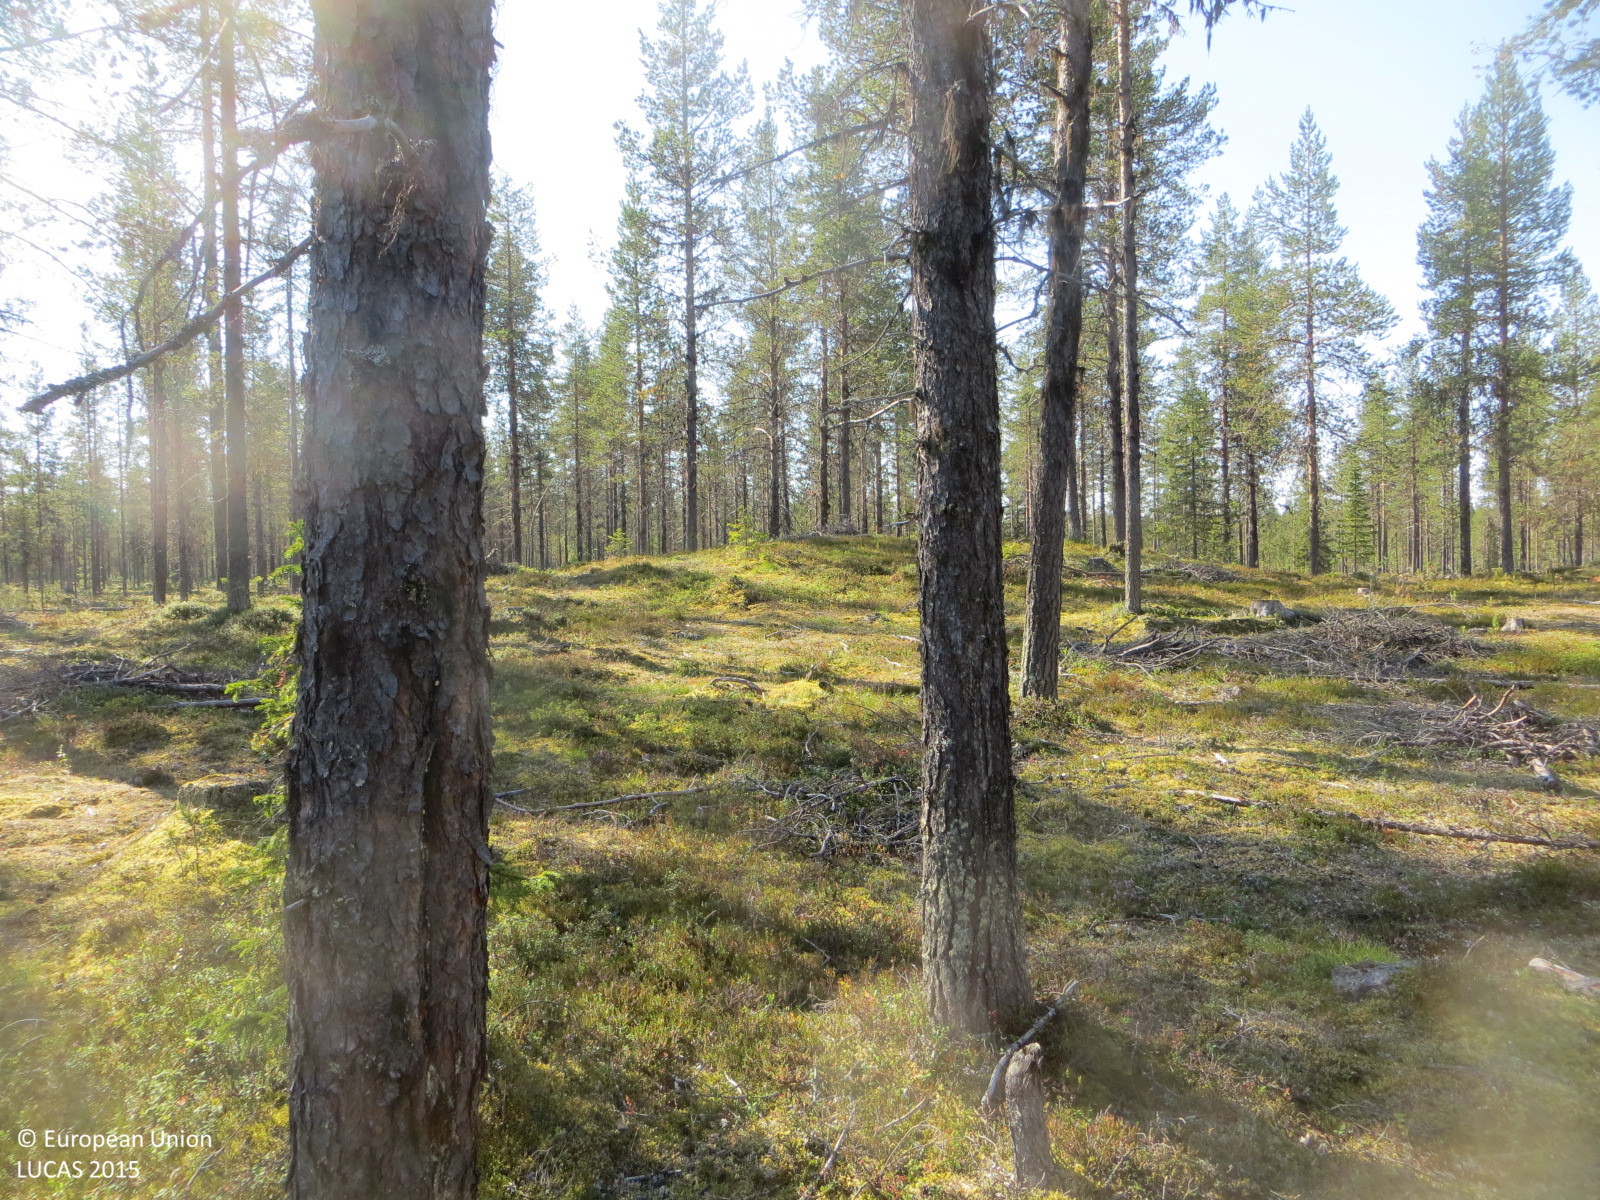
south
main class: Woodland
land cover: Pine dominated coniferous woodland
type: boreal forest
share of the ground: 50 - 75 %
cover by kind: coniferous forest trees 50 %, shrubs 50 %
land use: Forestry
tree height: > 5 m
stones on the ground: < 10 %
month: August
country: FI
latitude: 67.7104
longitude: 24.1264
